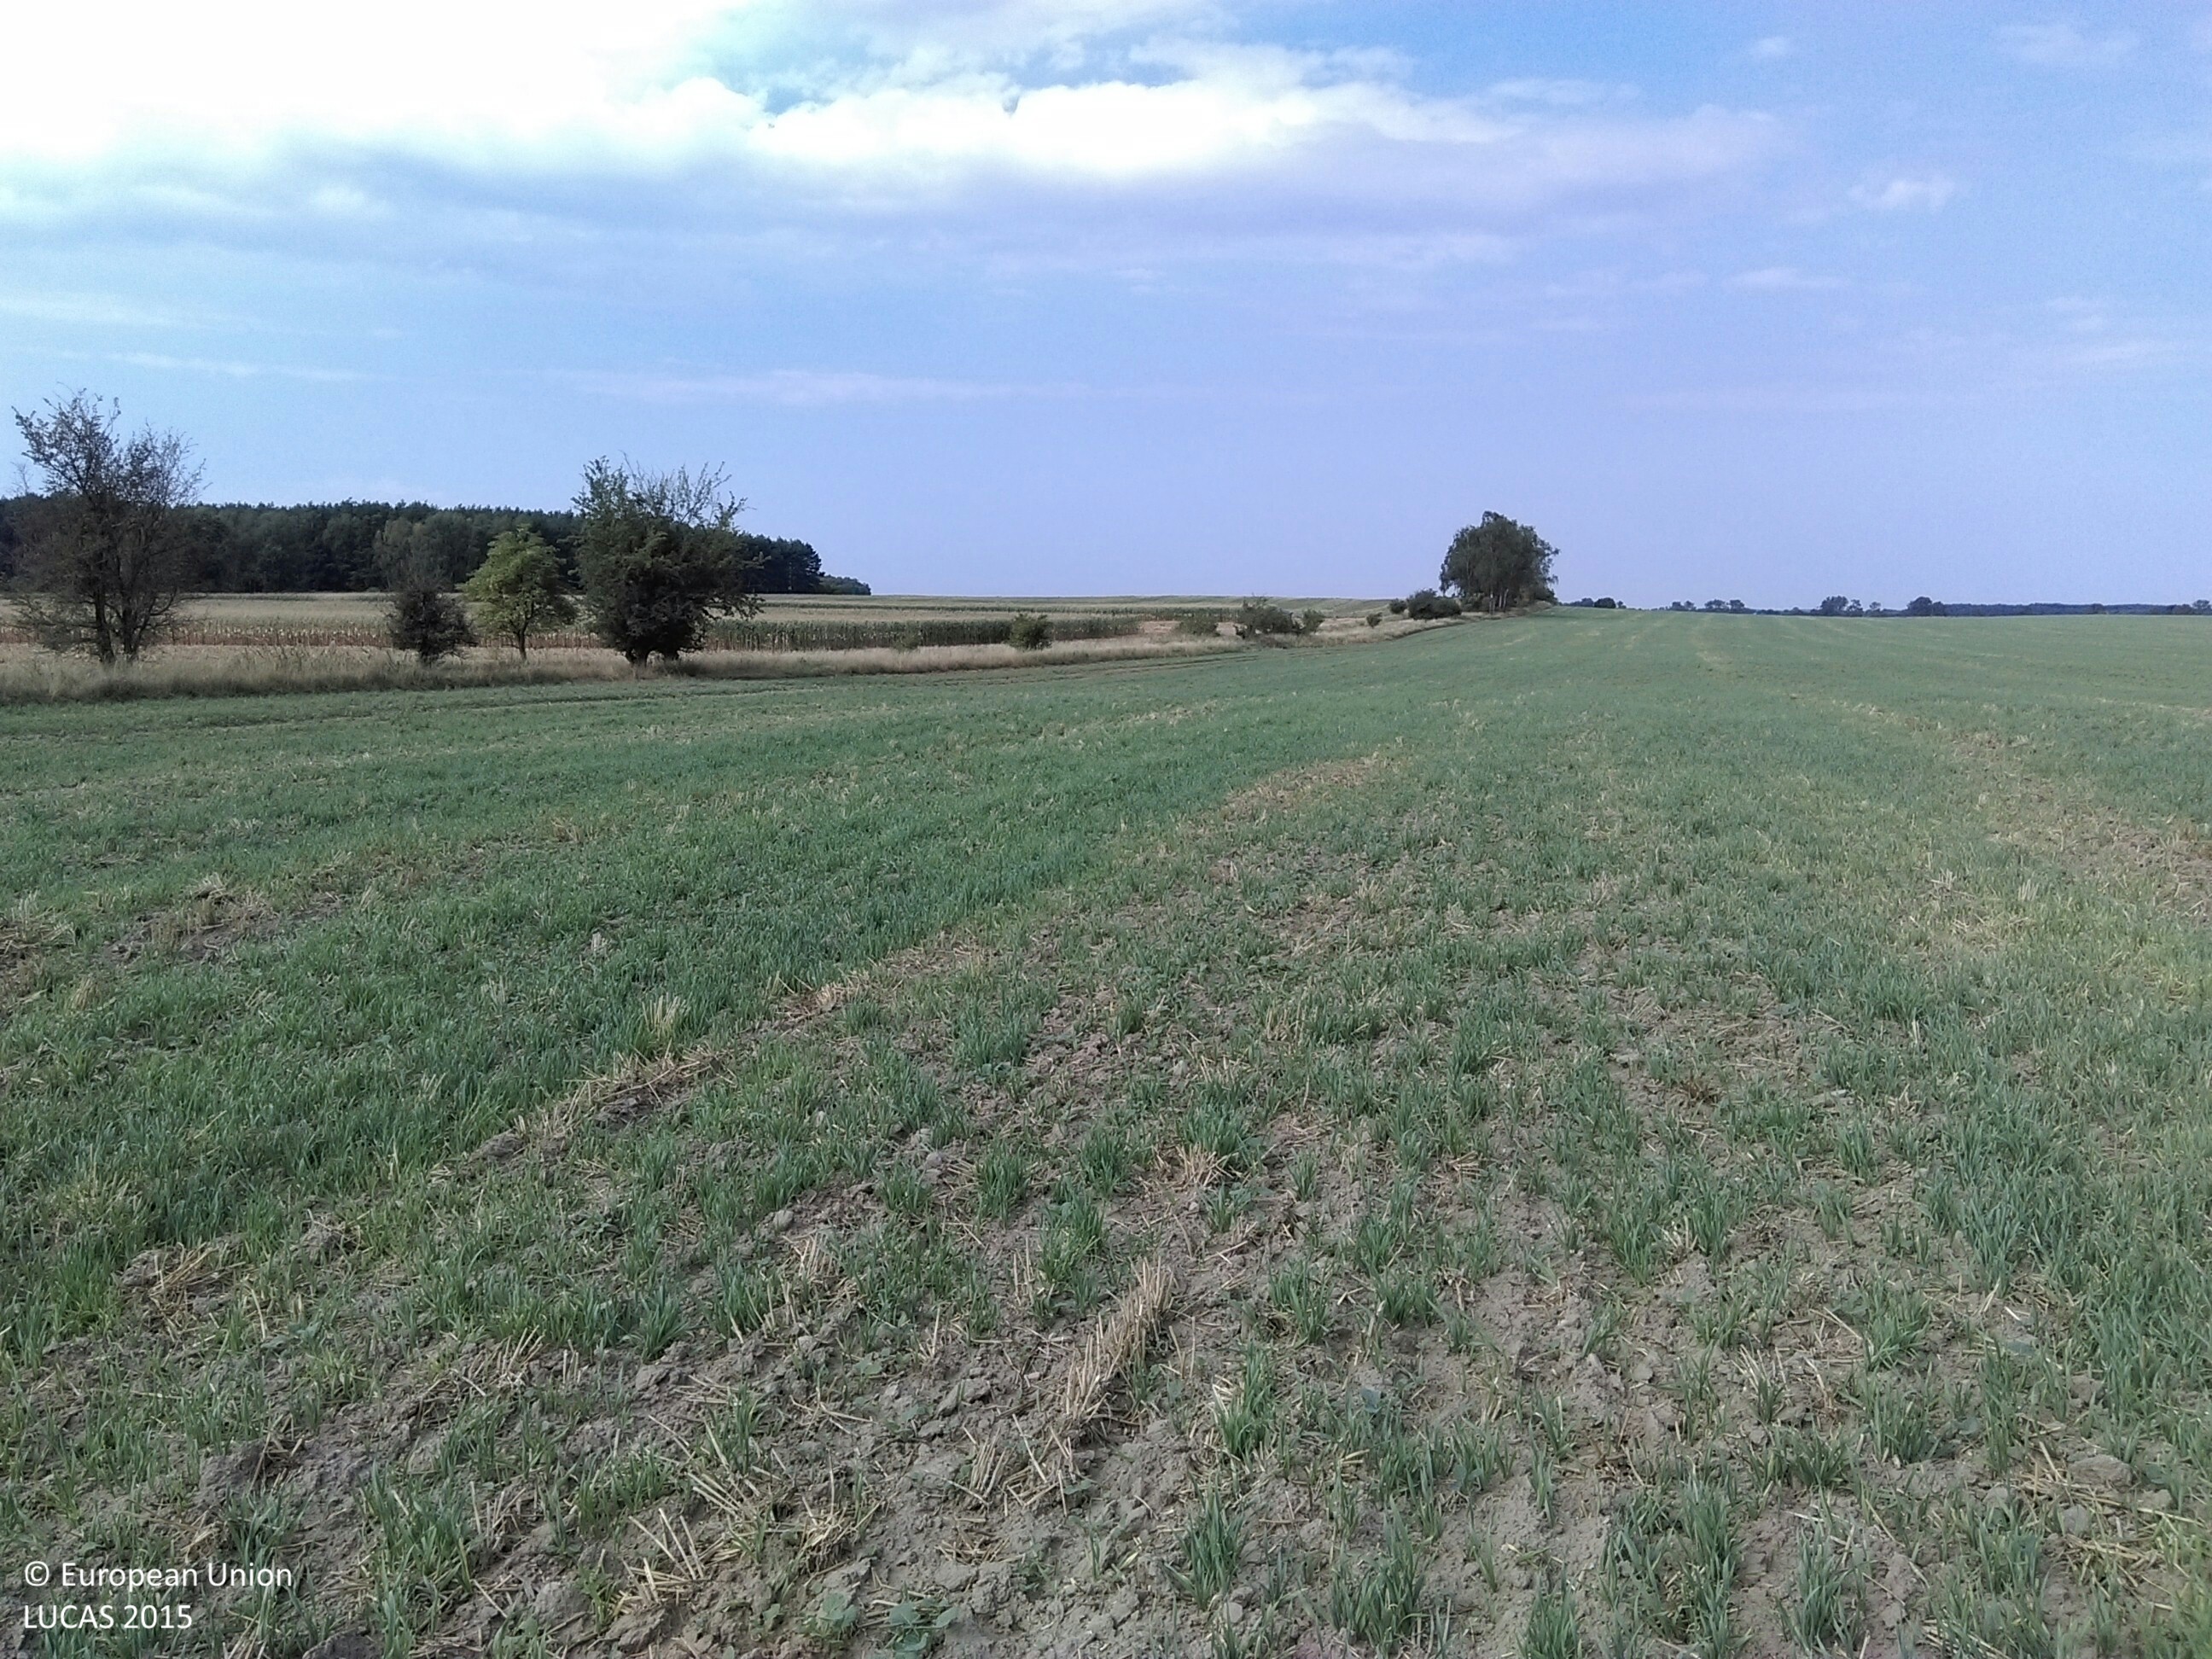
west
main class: Cropland
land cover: Rye
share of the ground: 50 - 75 %
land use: Agriculture (excluding fallow land and kitchen gardens)
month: August
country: PL
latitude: 52.2116
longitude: 15.5509
